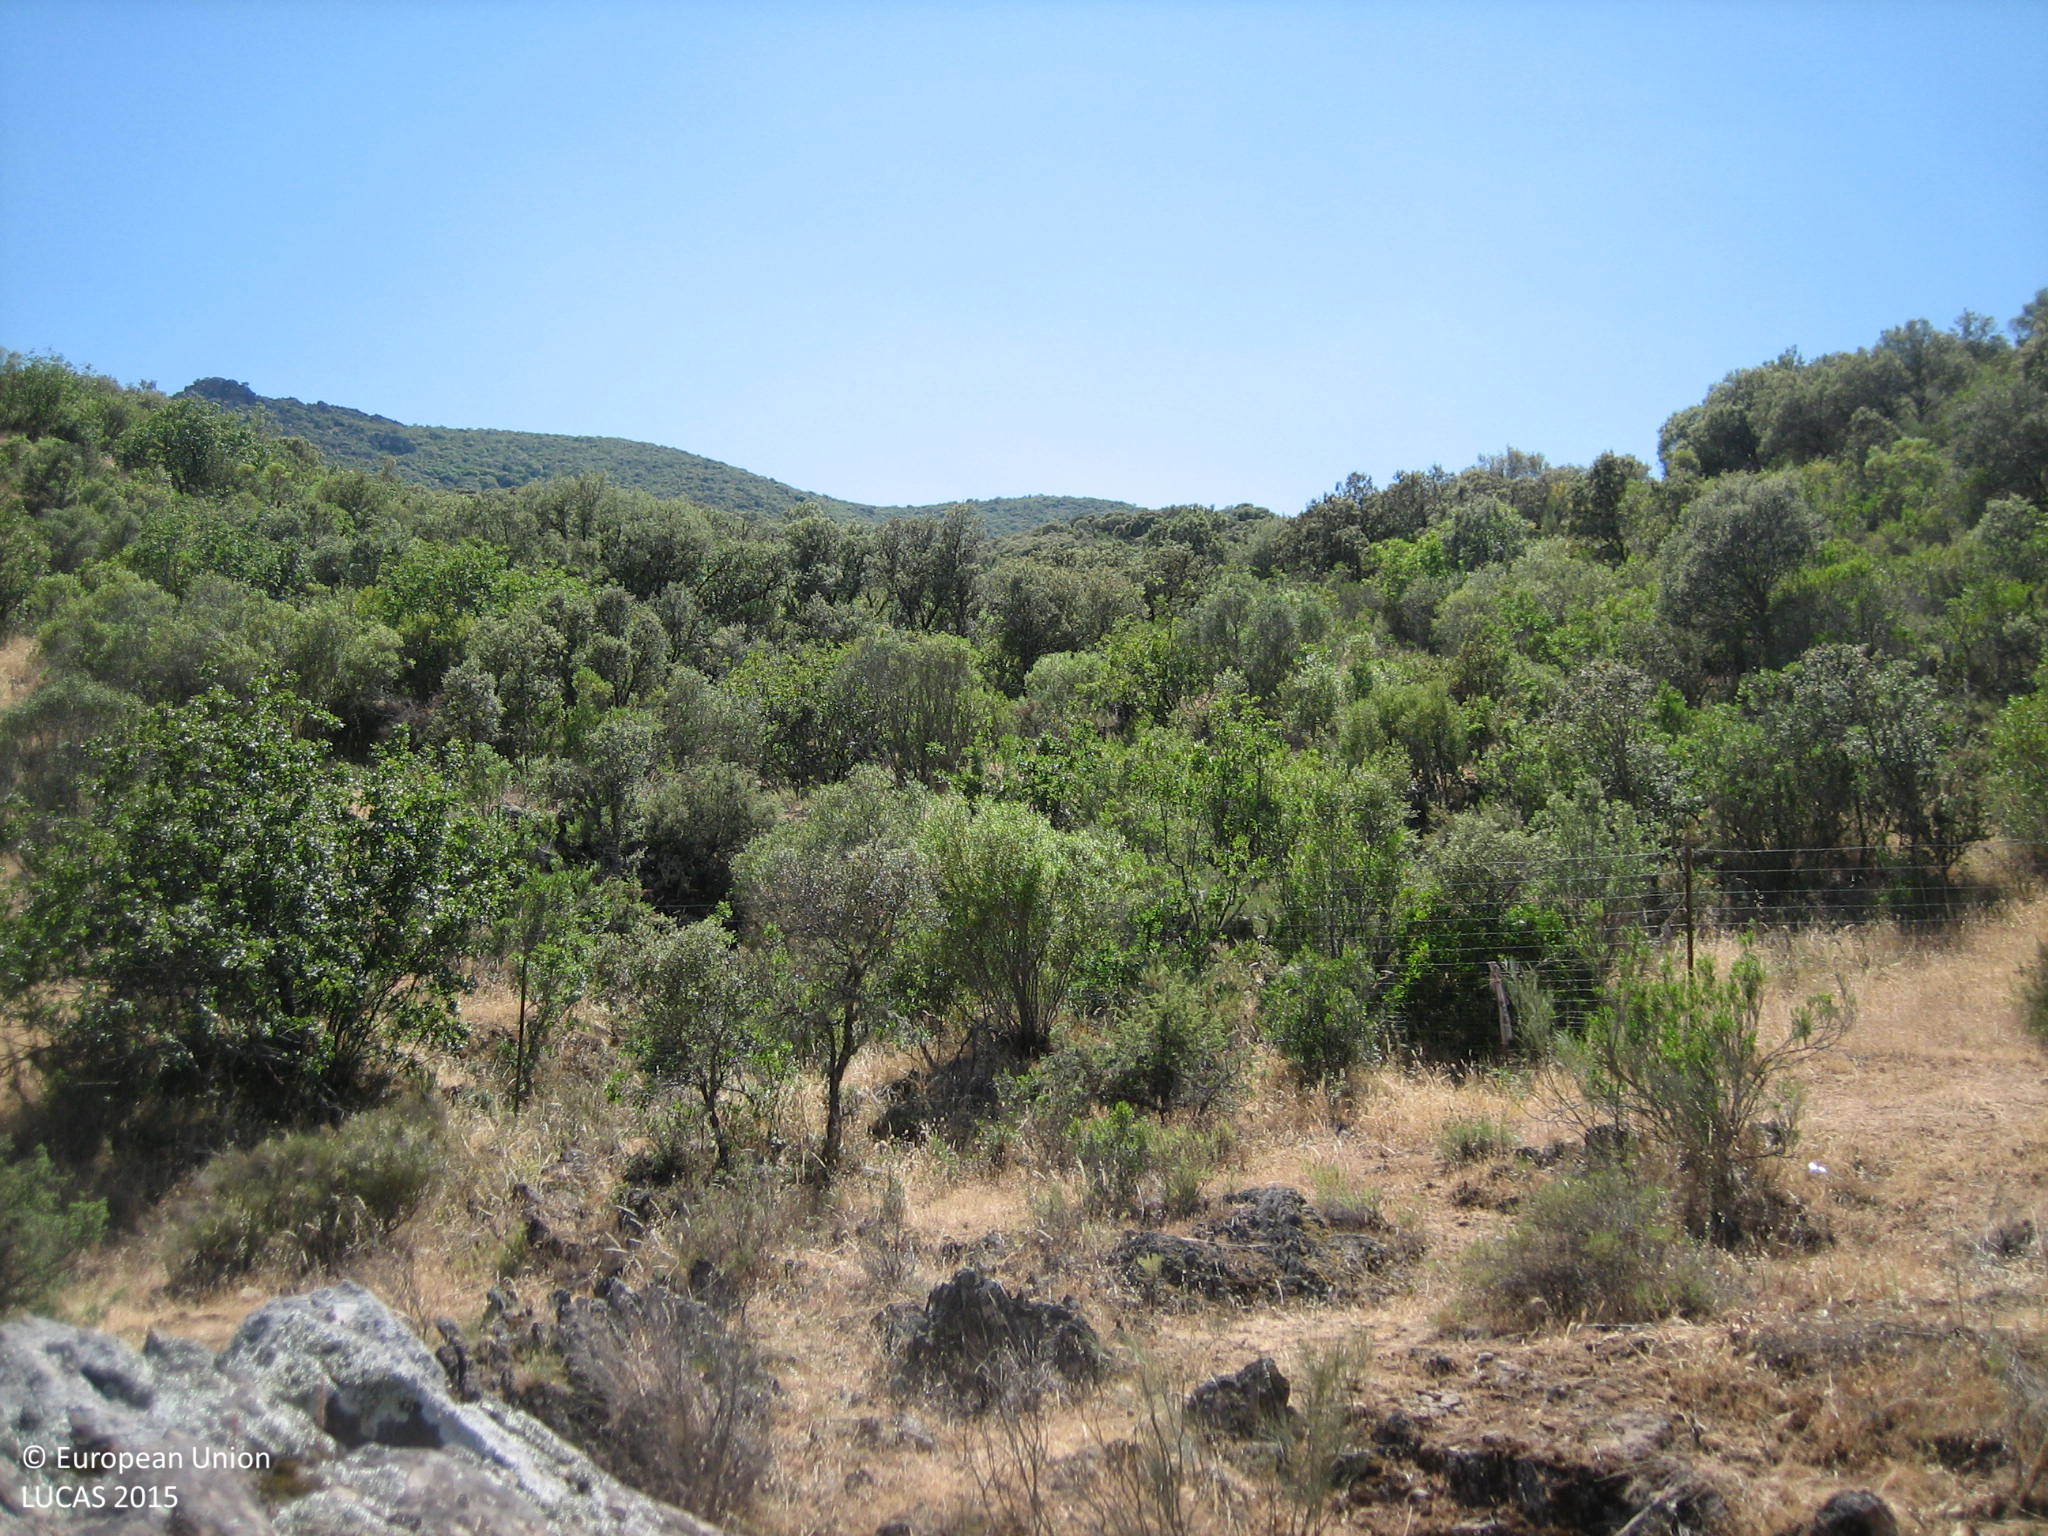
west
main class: Woodland
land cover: Broadleaved woodland
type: broadleaved evergreen forest
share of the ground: > 75 %
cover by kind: shrubs 80 %, broadleaved forest trees 20 %
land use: Forestry
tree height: < 5 m
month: May
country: ES
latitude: 38.4569
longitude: -3.9593
